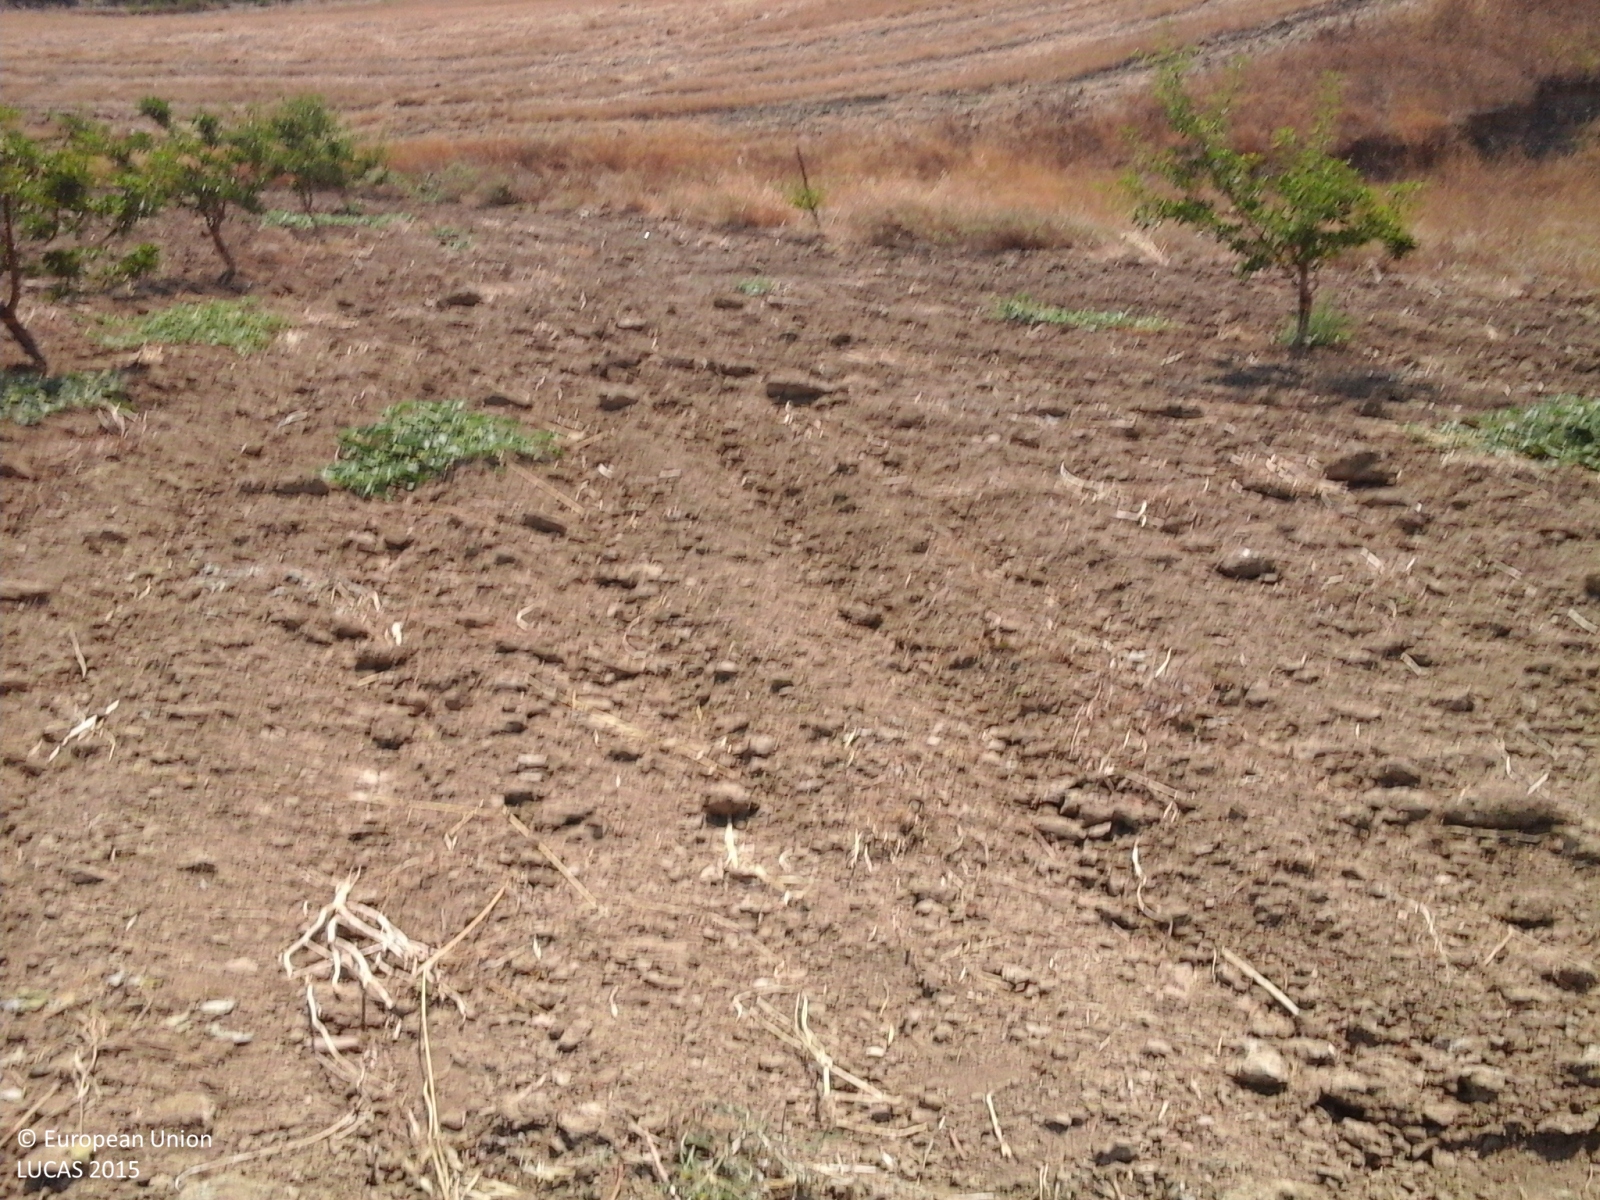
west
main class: Cropland
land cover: Nuts trees
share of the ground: > 75 %
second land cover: Other bare soil
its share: > 75 %
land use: Agriculture (excluding fallow land and kitchen gardens)
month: July
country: IT
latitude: 37.2771
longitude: 14.1074
